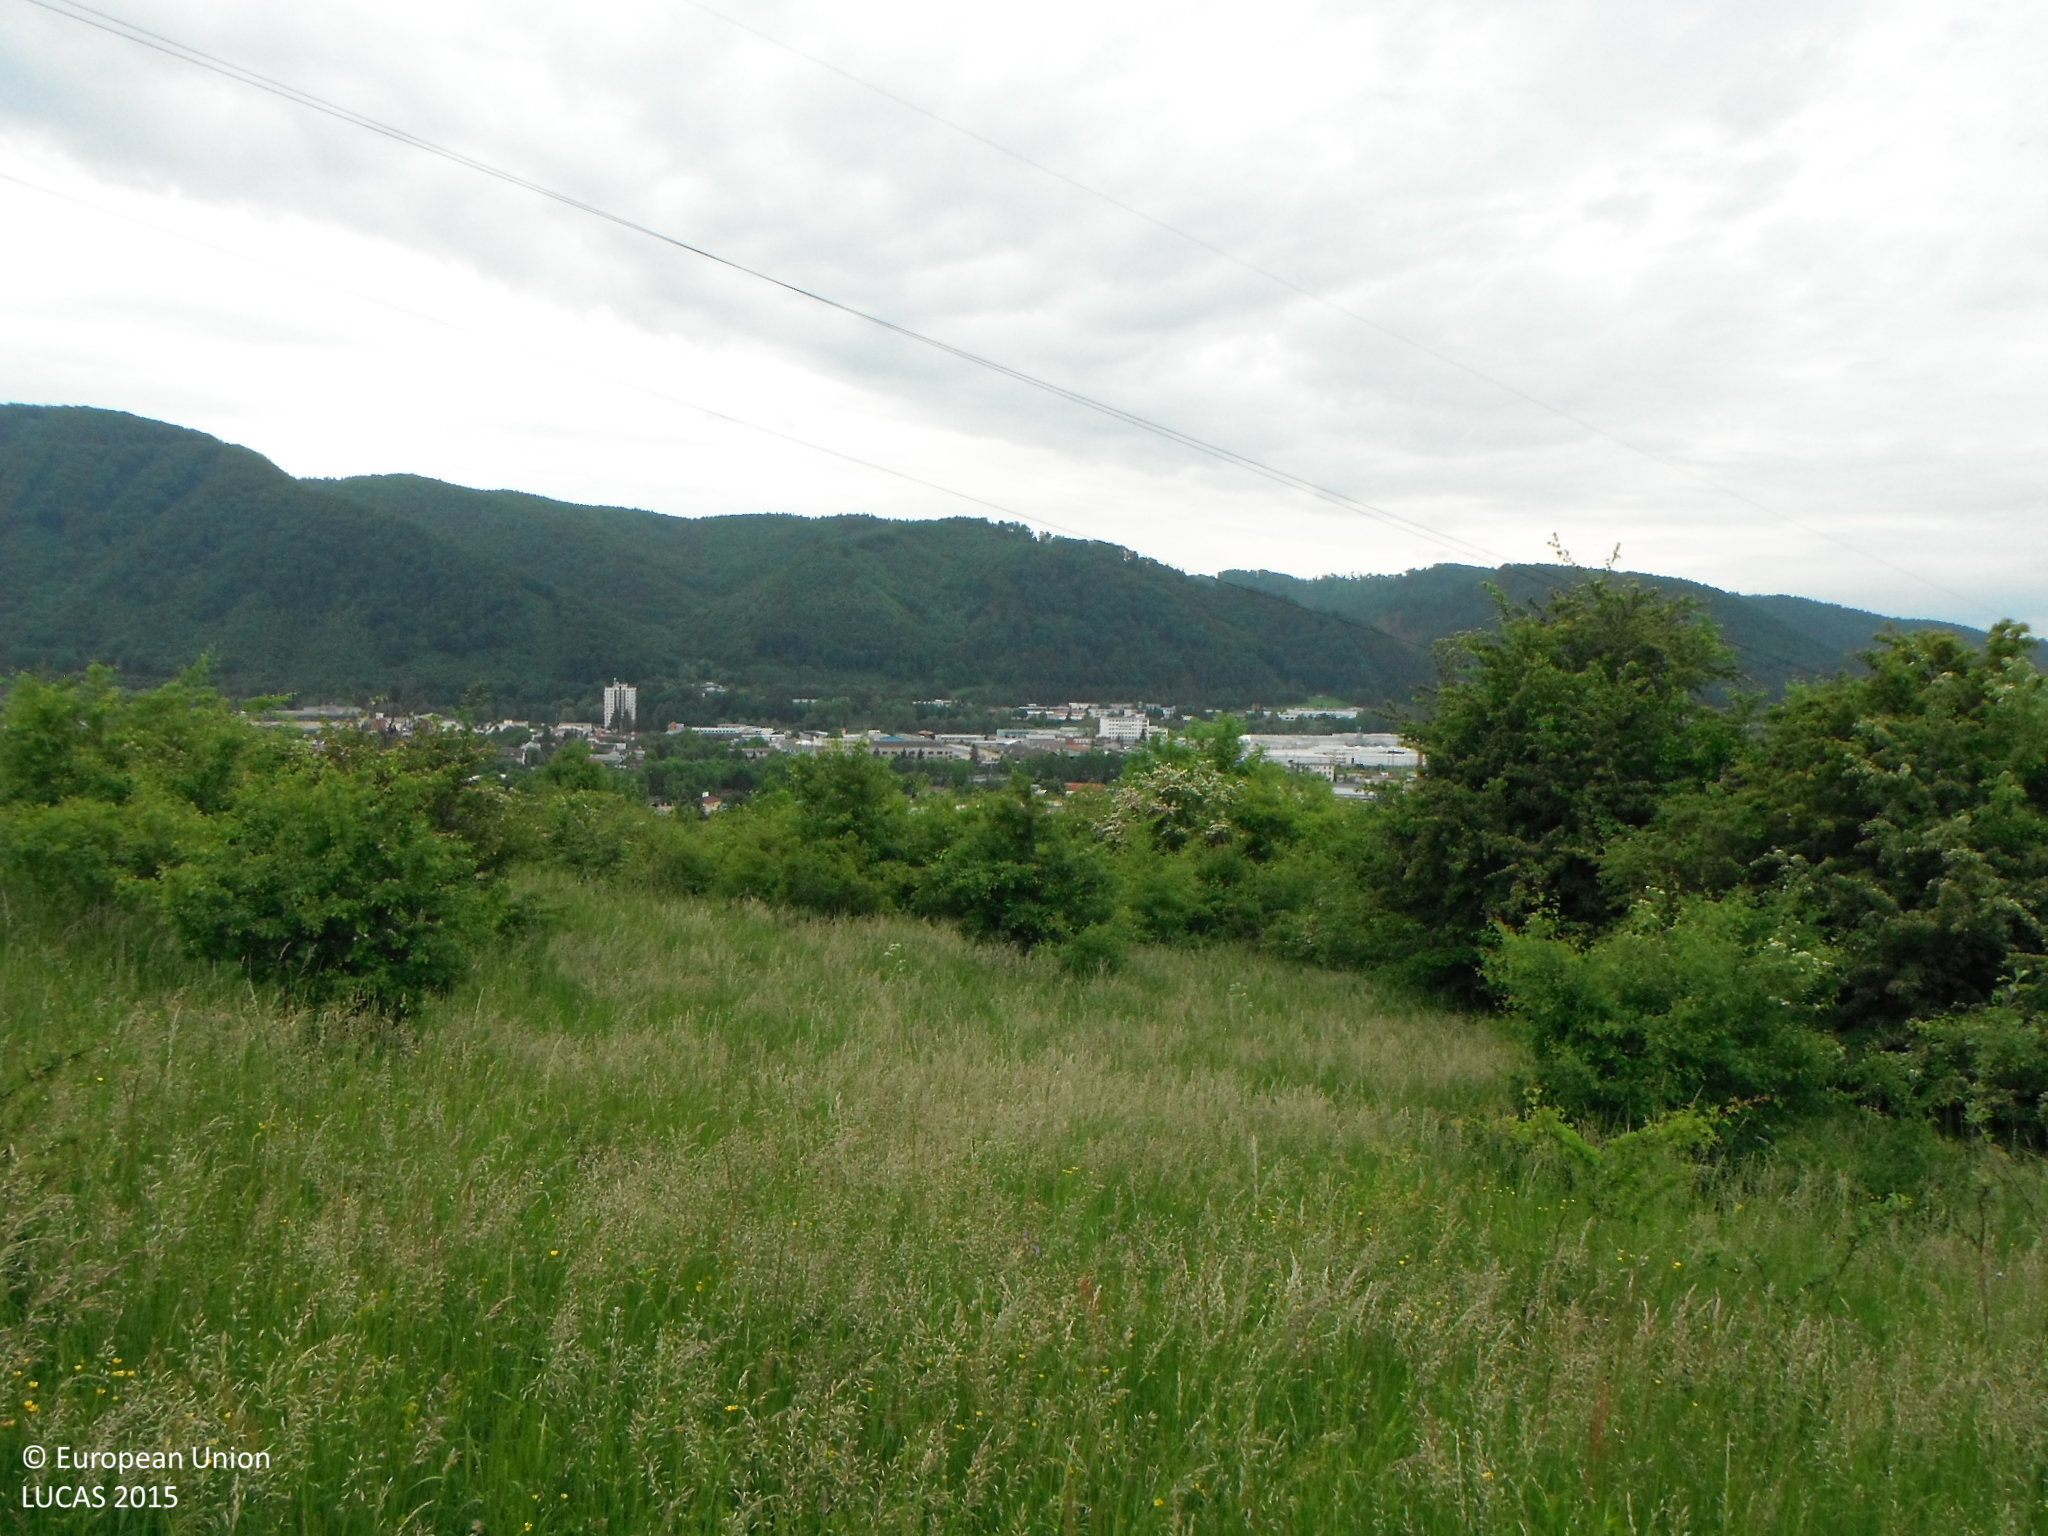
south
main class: Grassland
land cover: Grassland with sparse tree/shrub cover
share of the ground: > 75 %
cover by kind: herbaceous plants 85 %, shrubs 10 %, broadleaved forest trees 5 %
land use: Agriculture (excluding fallow land and kitchen gardens)
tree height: < 5 m
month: May
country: SK
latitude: 48.7456
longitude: 19.1751
